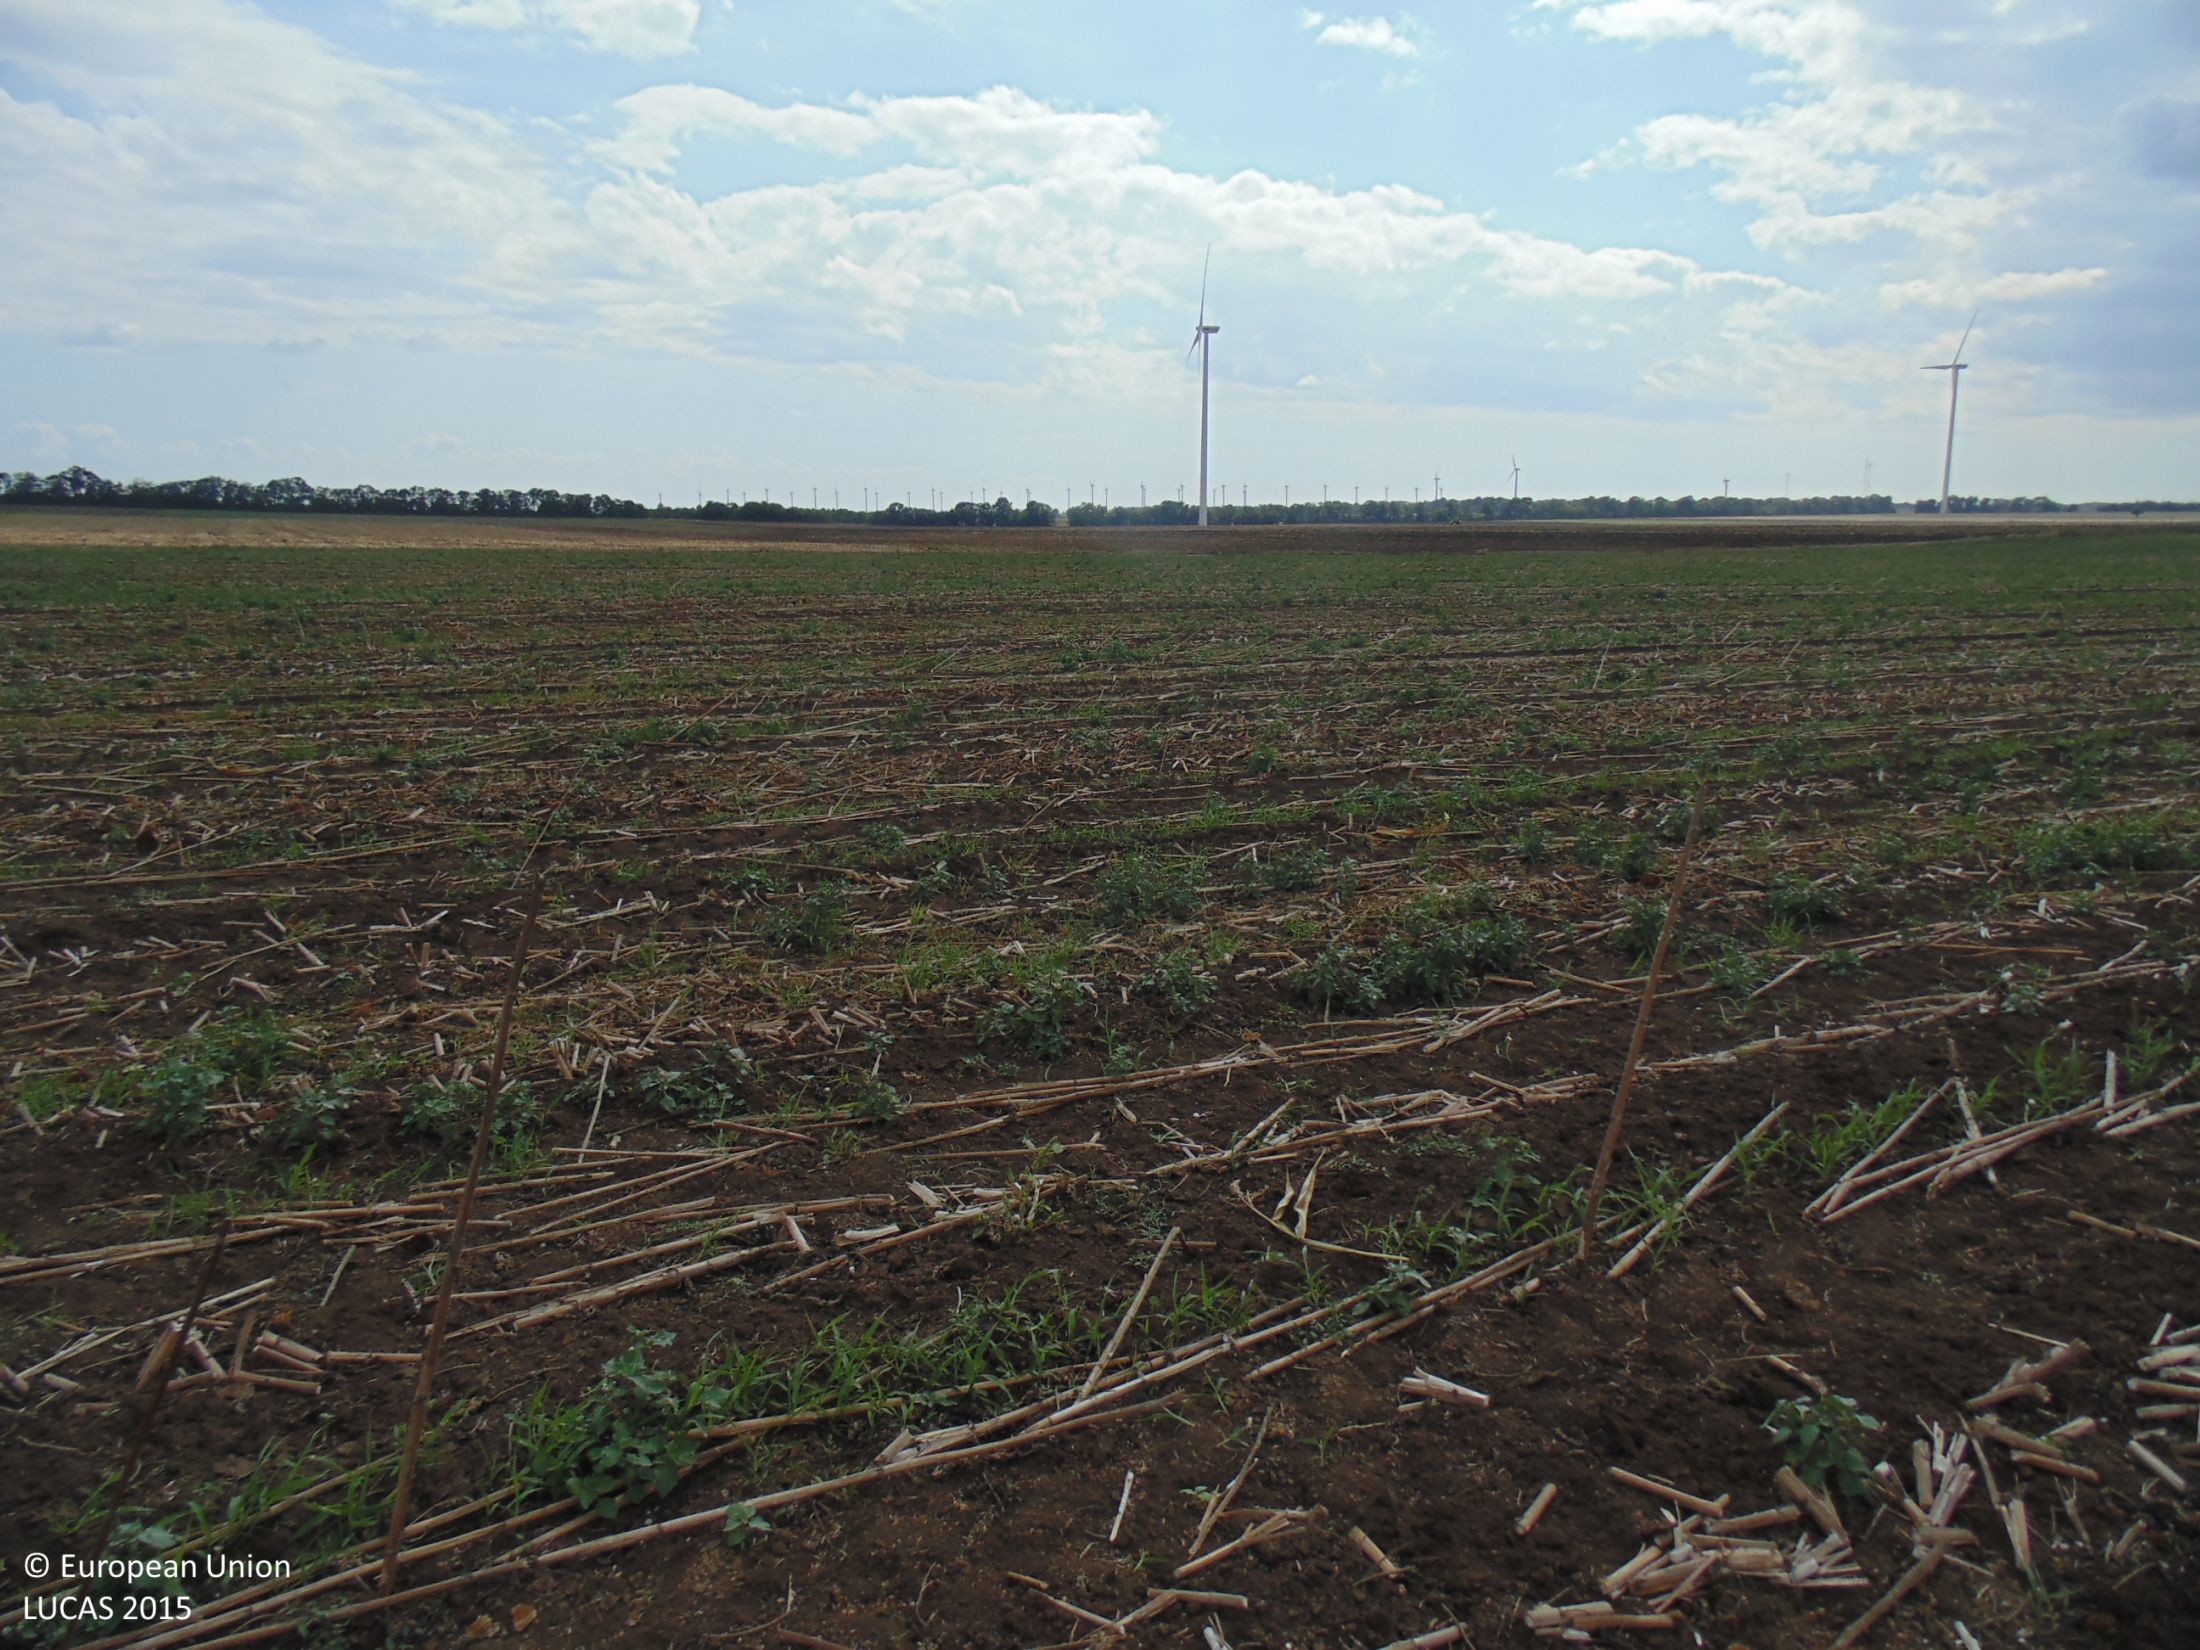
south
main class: Cropland
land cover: Sunflower
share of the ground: < 10 %
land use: Agriculture (excluding fallow land and kitchen gardens)
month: September
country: BG
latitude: 43.4346
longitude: 28.4552
